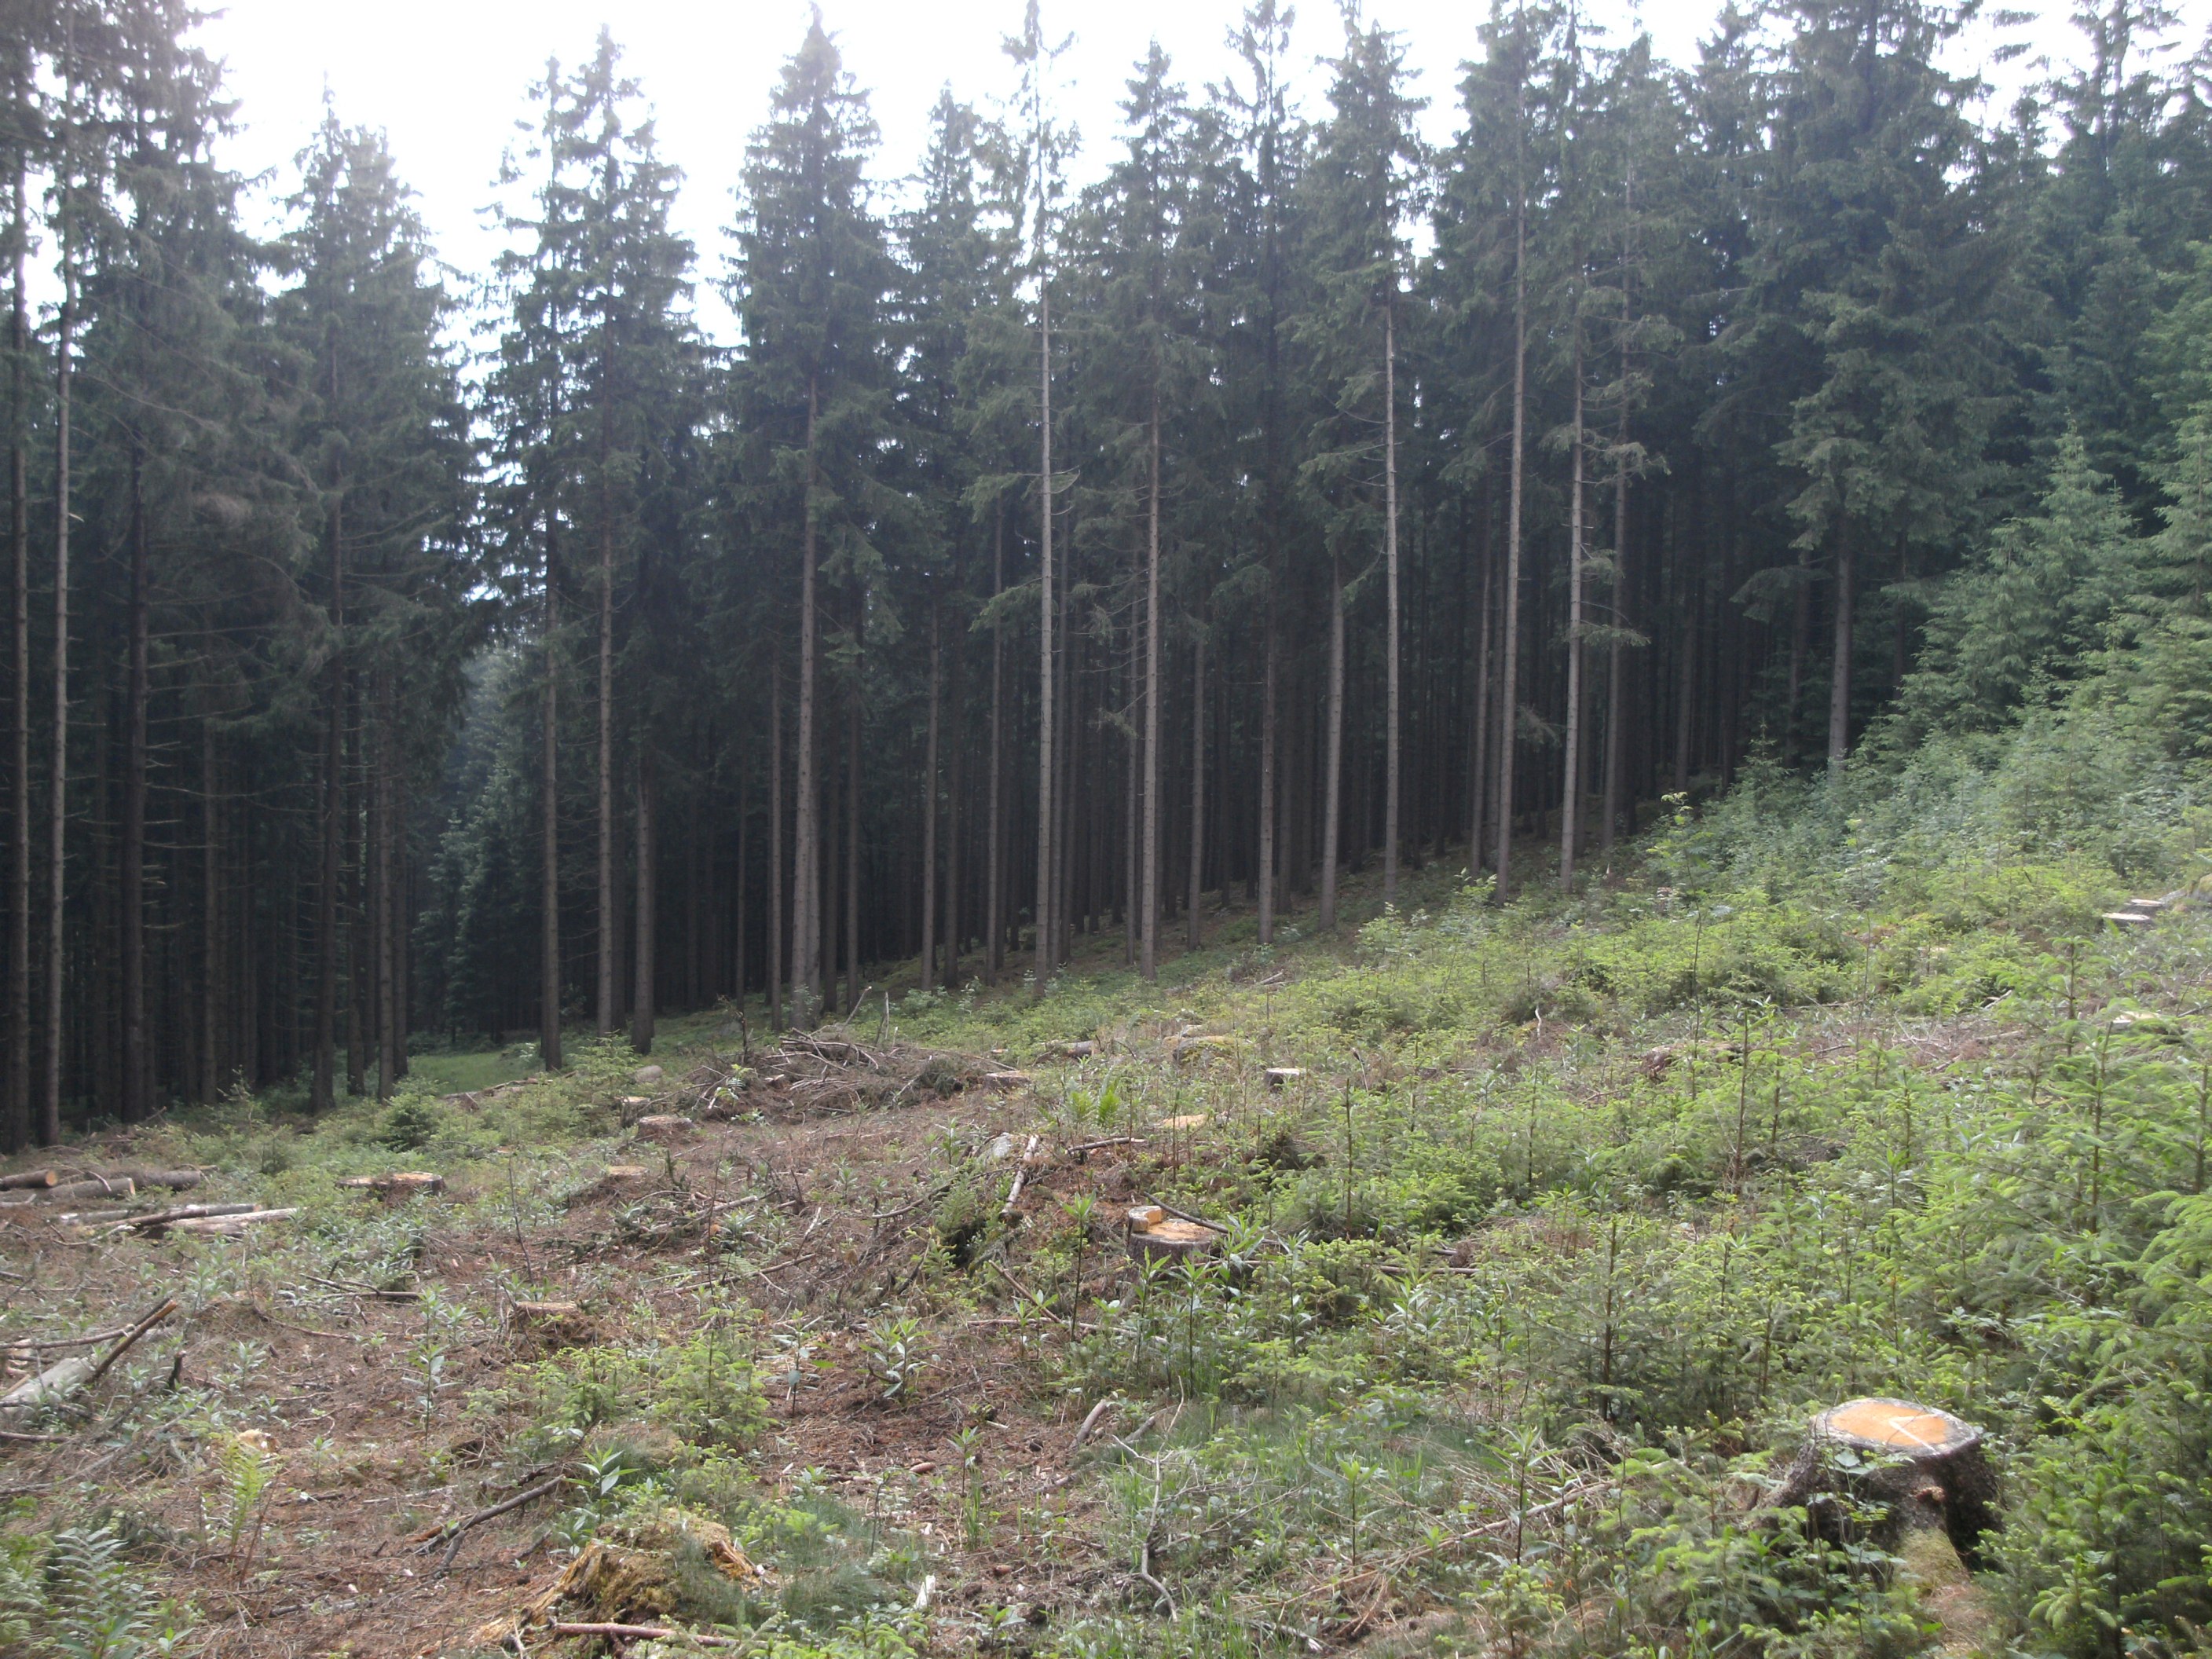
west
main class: Woodland
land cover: Spruce dominated coniferous woodland
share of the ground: 50 - 75 %
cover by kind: coniferous forest trees 65 %, herbaceous plants 10 %, lichens and mosses 10 %, consolidated bare surface 10 %, shrubs 5 %
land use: Forestry
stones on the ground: < 10 %
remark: Clear cut
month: June
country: AT
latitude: 48.5543
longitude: 14.2952
